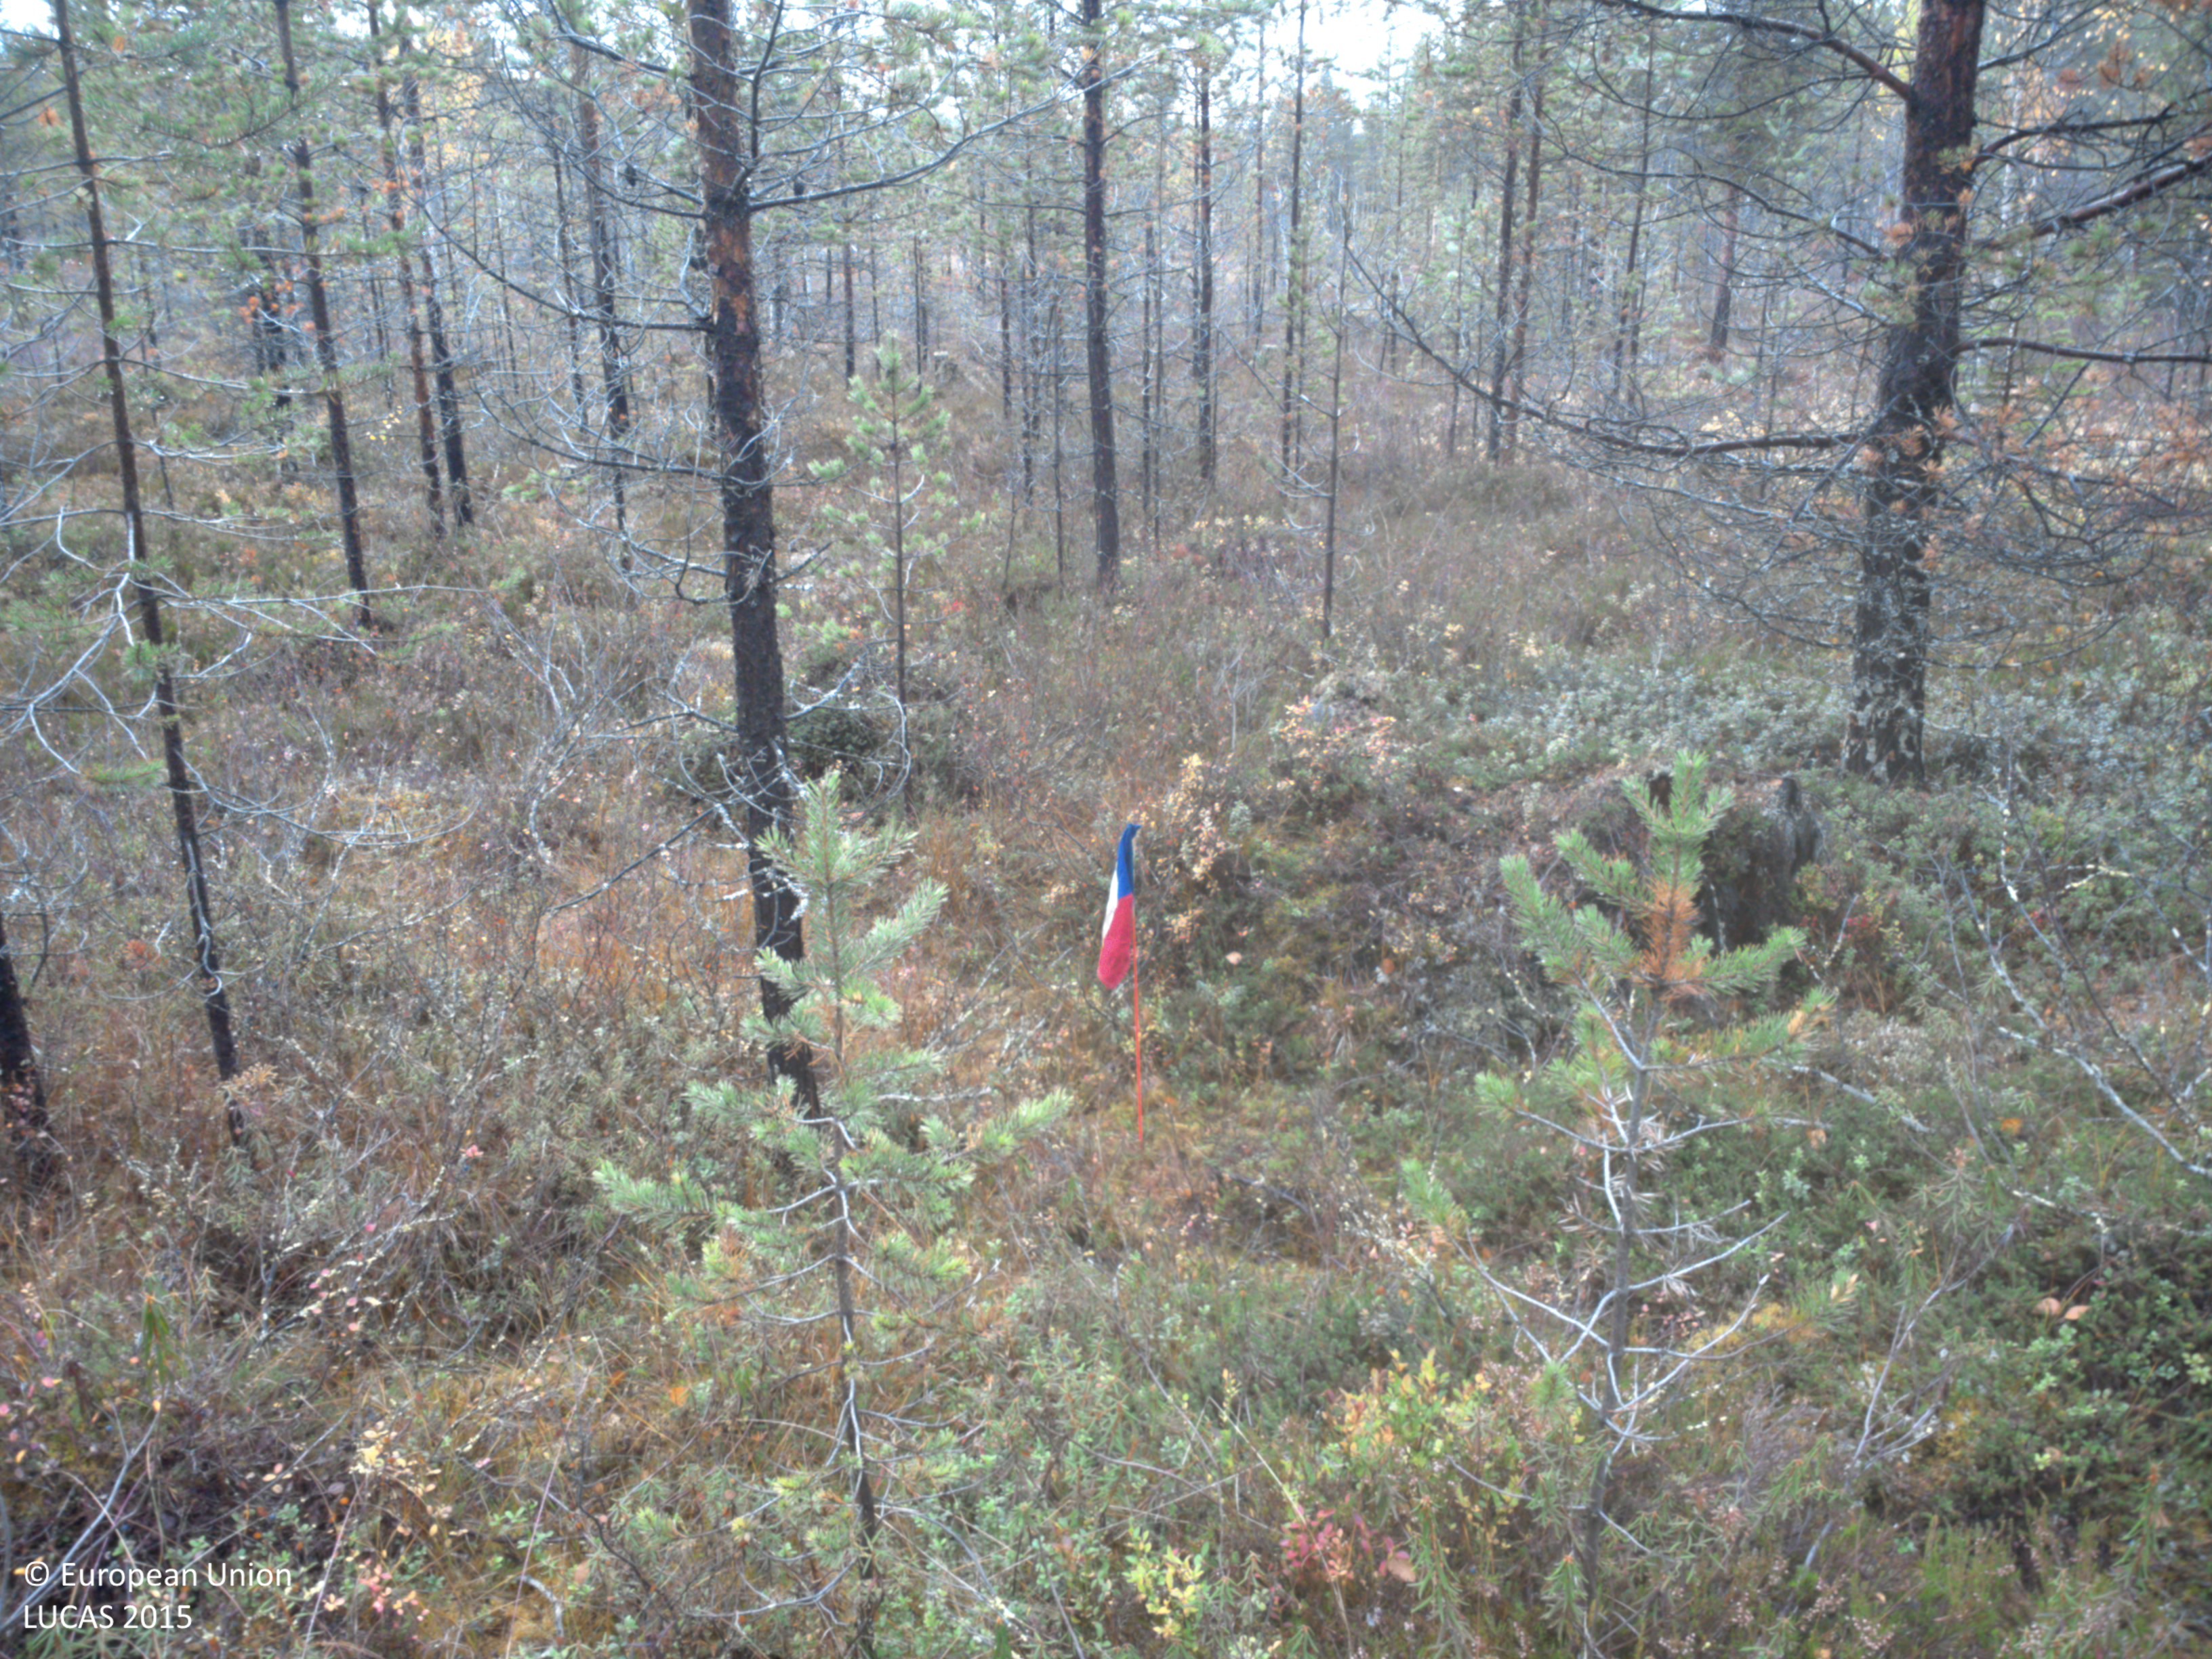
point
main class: Woodland
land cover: Pine dominated coniferous woodland
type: boreal forest
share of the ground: 50 - 75 %
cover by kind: coniferous forest trees 65 %, shrubs 20 %, broadleaved forest trees 5 %, herbaceous plants 5 %, lichens and mosses 5 %
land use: Forestry
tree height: > 5 m
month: September
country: SE
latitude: 64.8871
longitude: 19.0259
